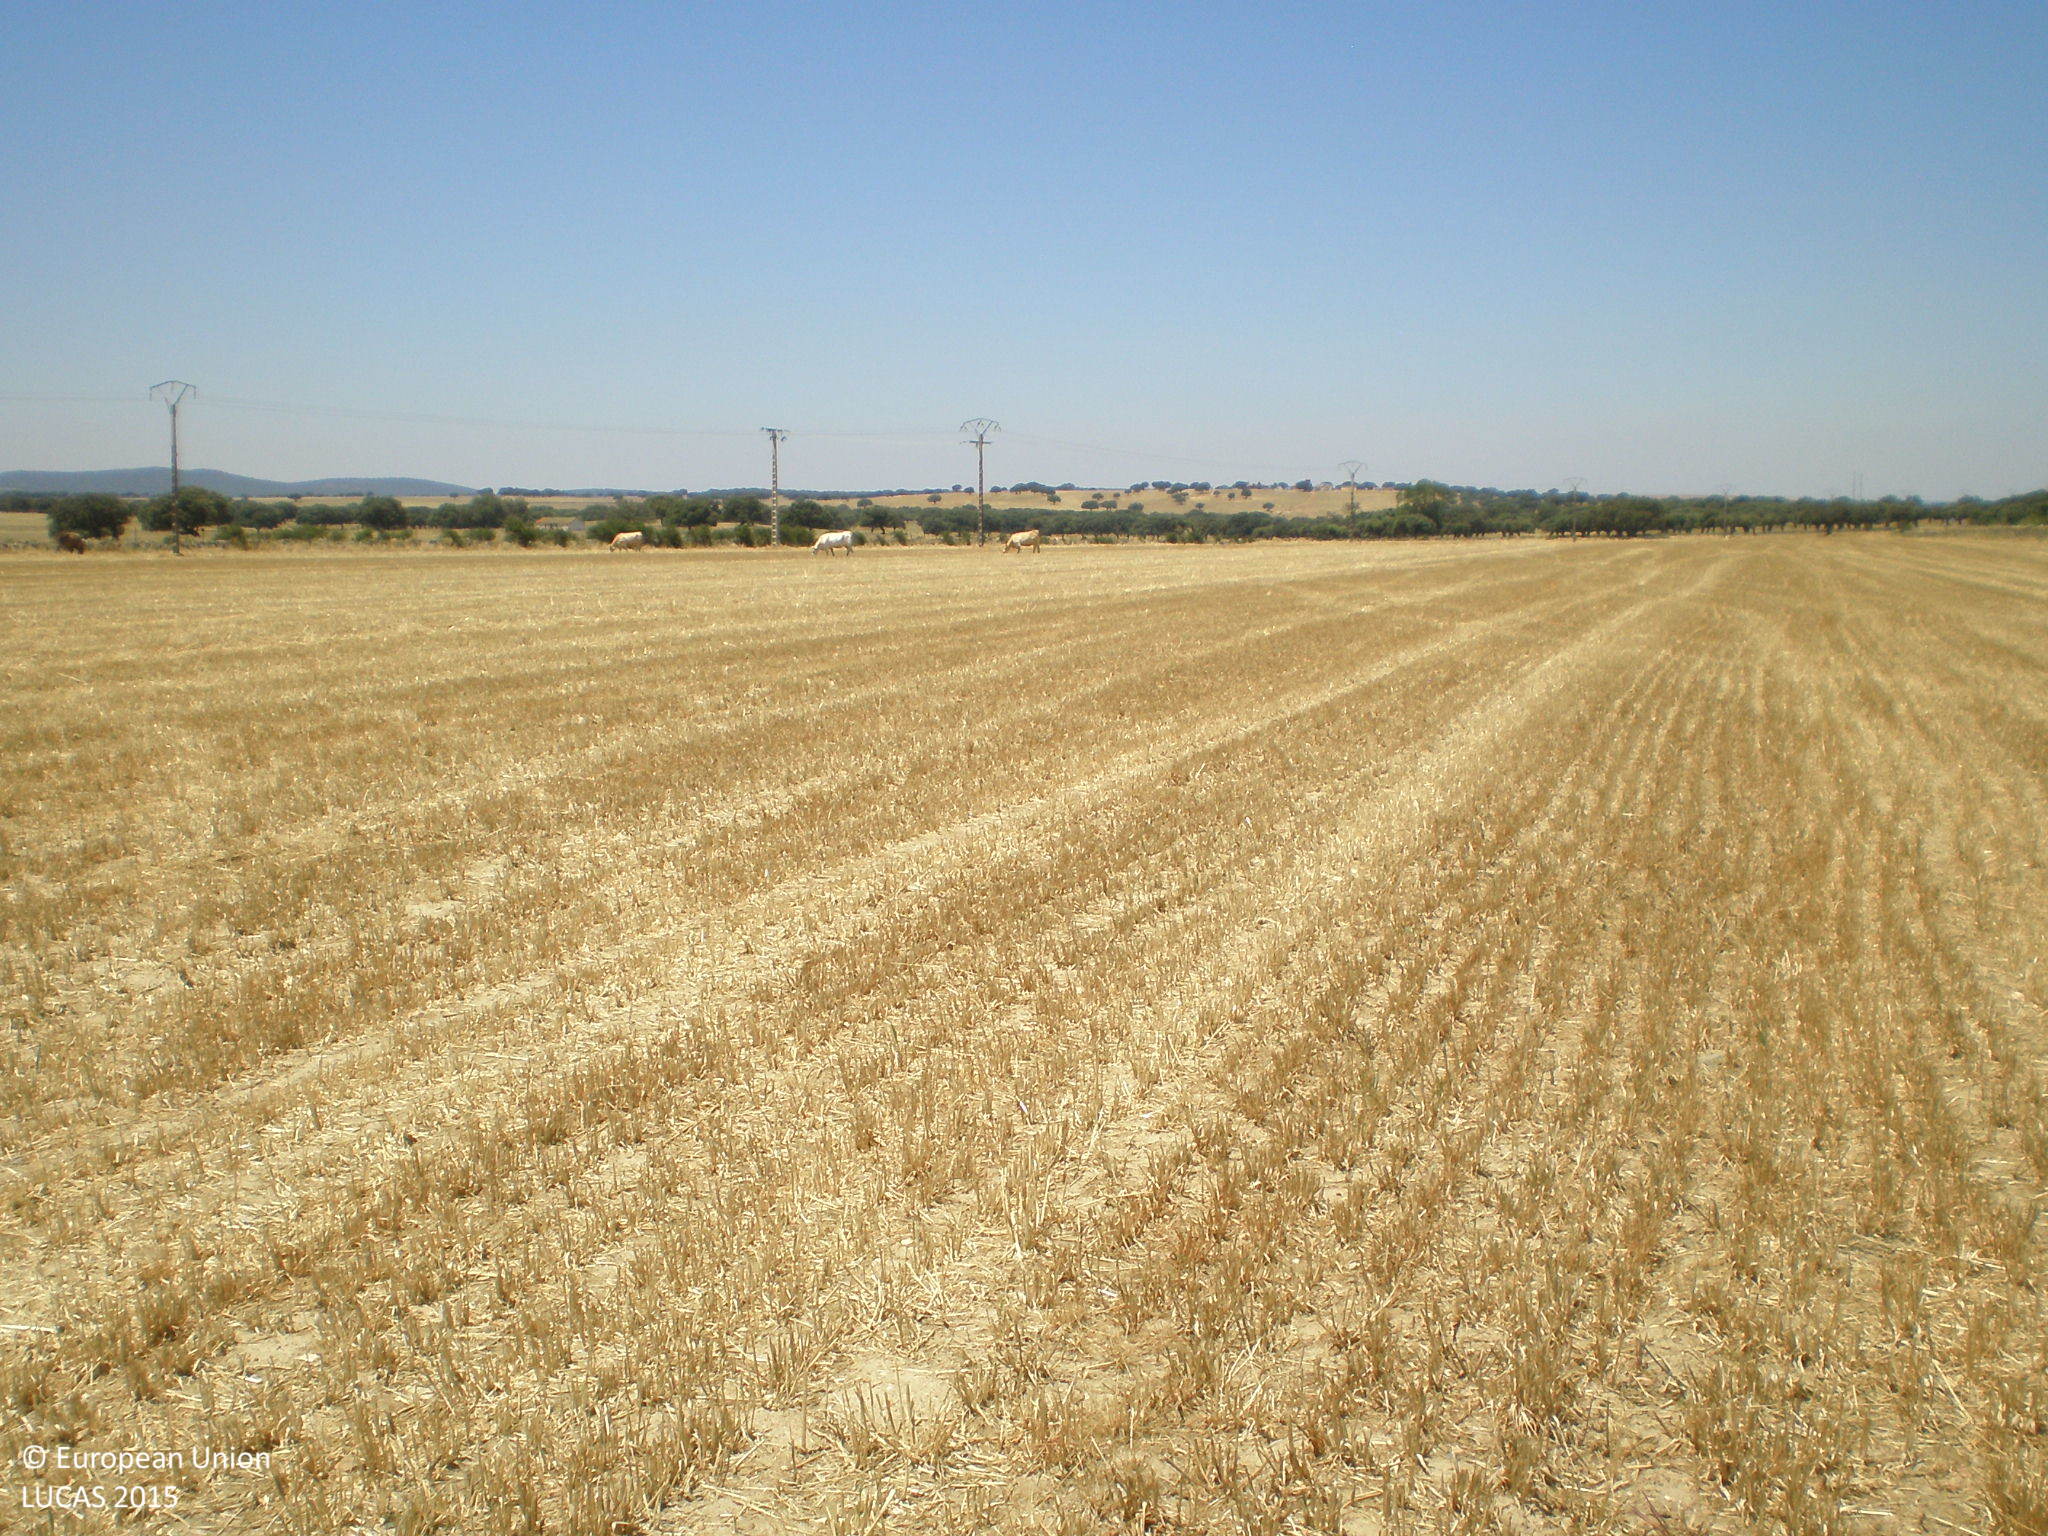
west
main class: Cropland
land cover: Oats
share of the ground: < 10 %
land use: Agriculture (excluding fallow land and kitchen gardens)
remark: Harvested field
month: June
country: ES
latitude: 40.7547
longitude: -5.8430
